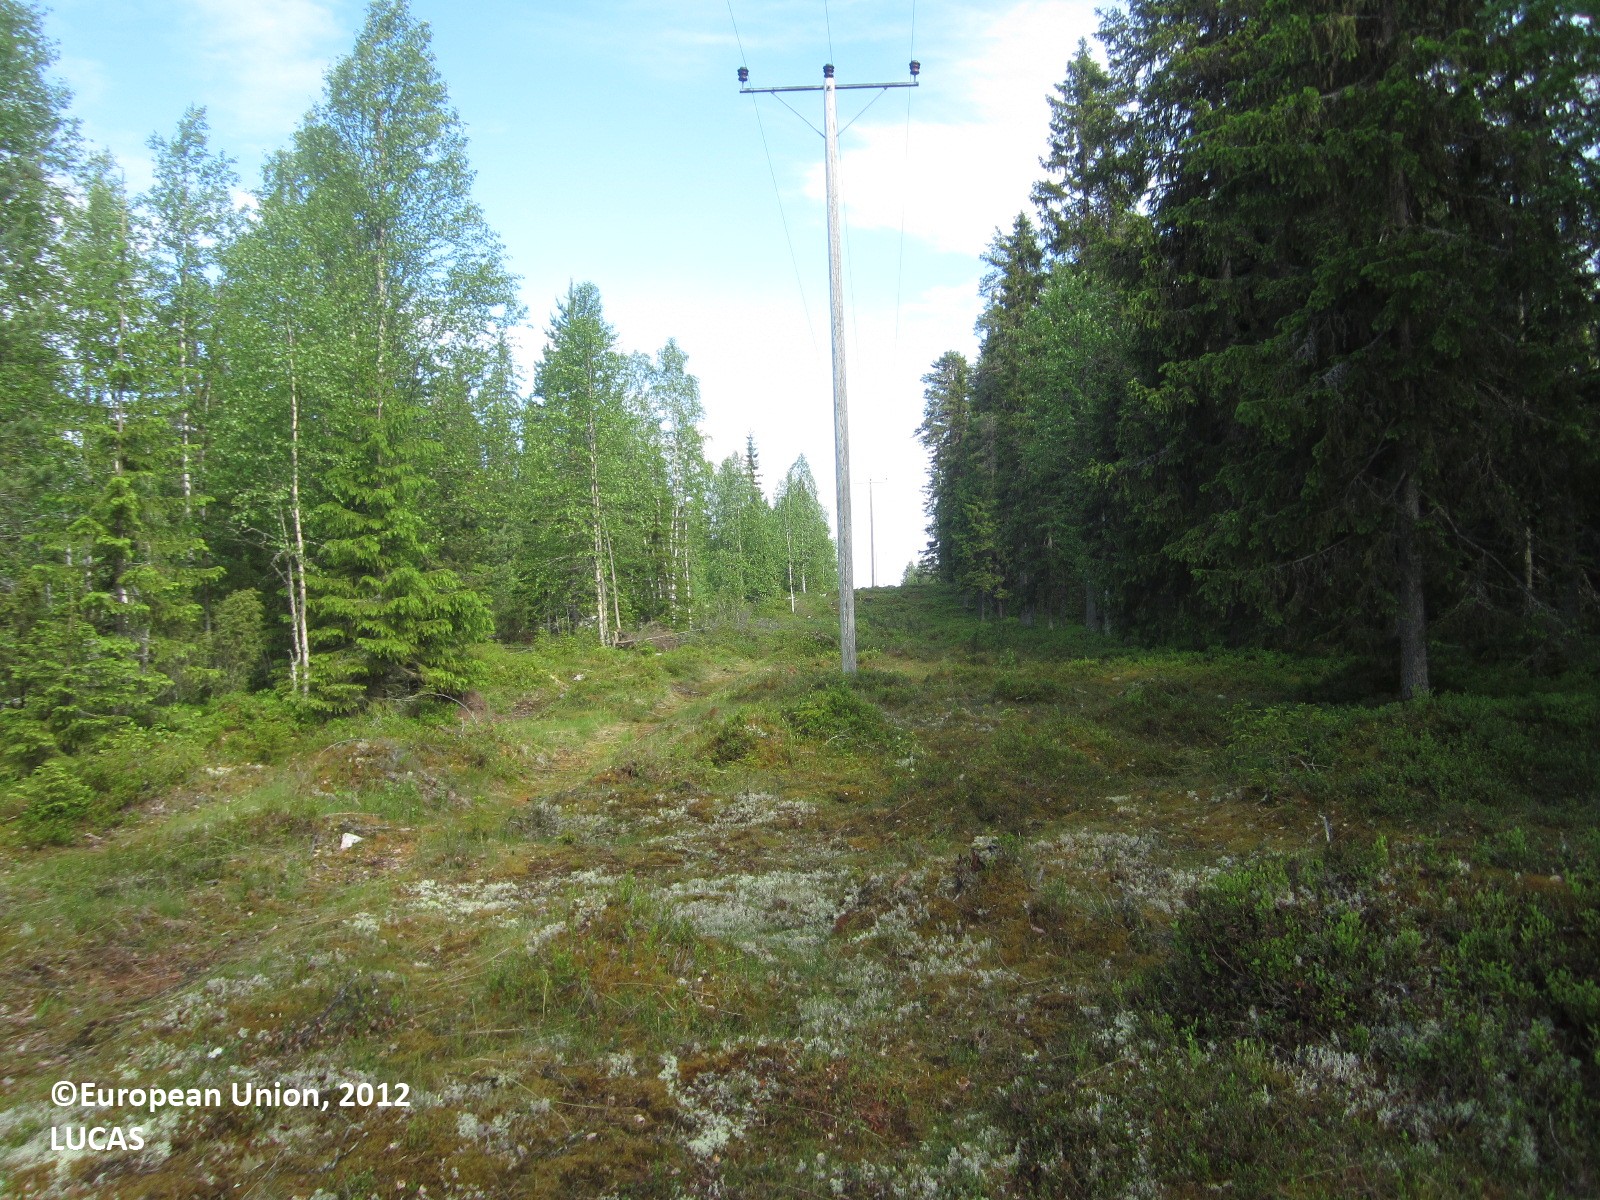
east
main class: Shrubland
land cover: Shrubland without tree cover
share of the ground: 50 - 75 %
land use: Energy production
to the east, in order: Shrubland without tree cover; Electric lines; Shrubland without tree cover; Shrubland with sparse tree cover; Tracks; Groves; Shrubland without tree cover; Ditches and canals; Paved roads, cycling and walking lanes; Ditches and canals; Shrubland without tree cover; Spruce dominated coniferous woodland
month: June
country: FI
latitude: 64.6412
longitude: 30.0077
